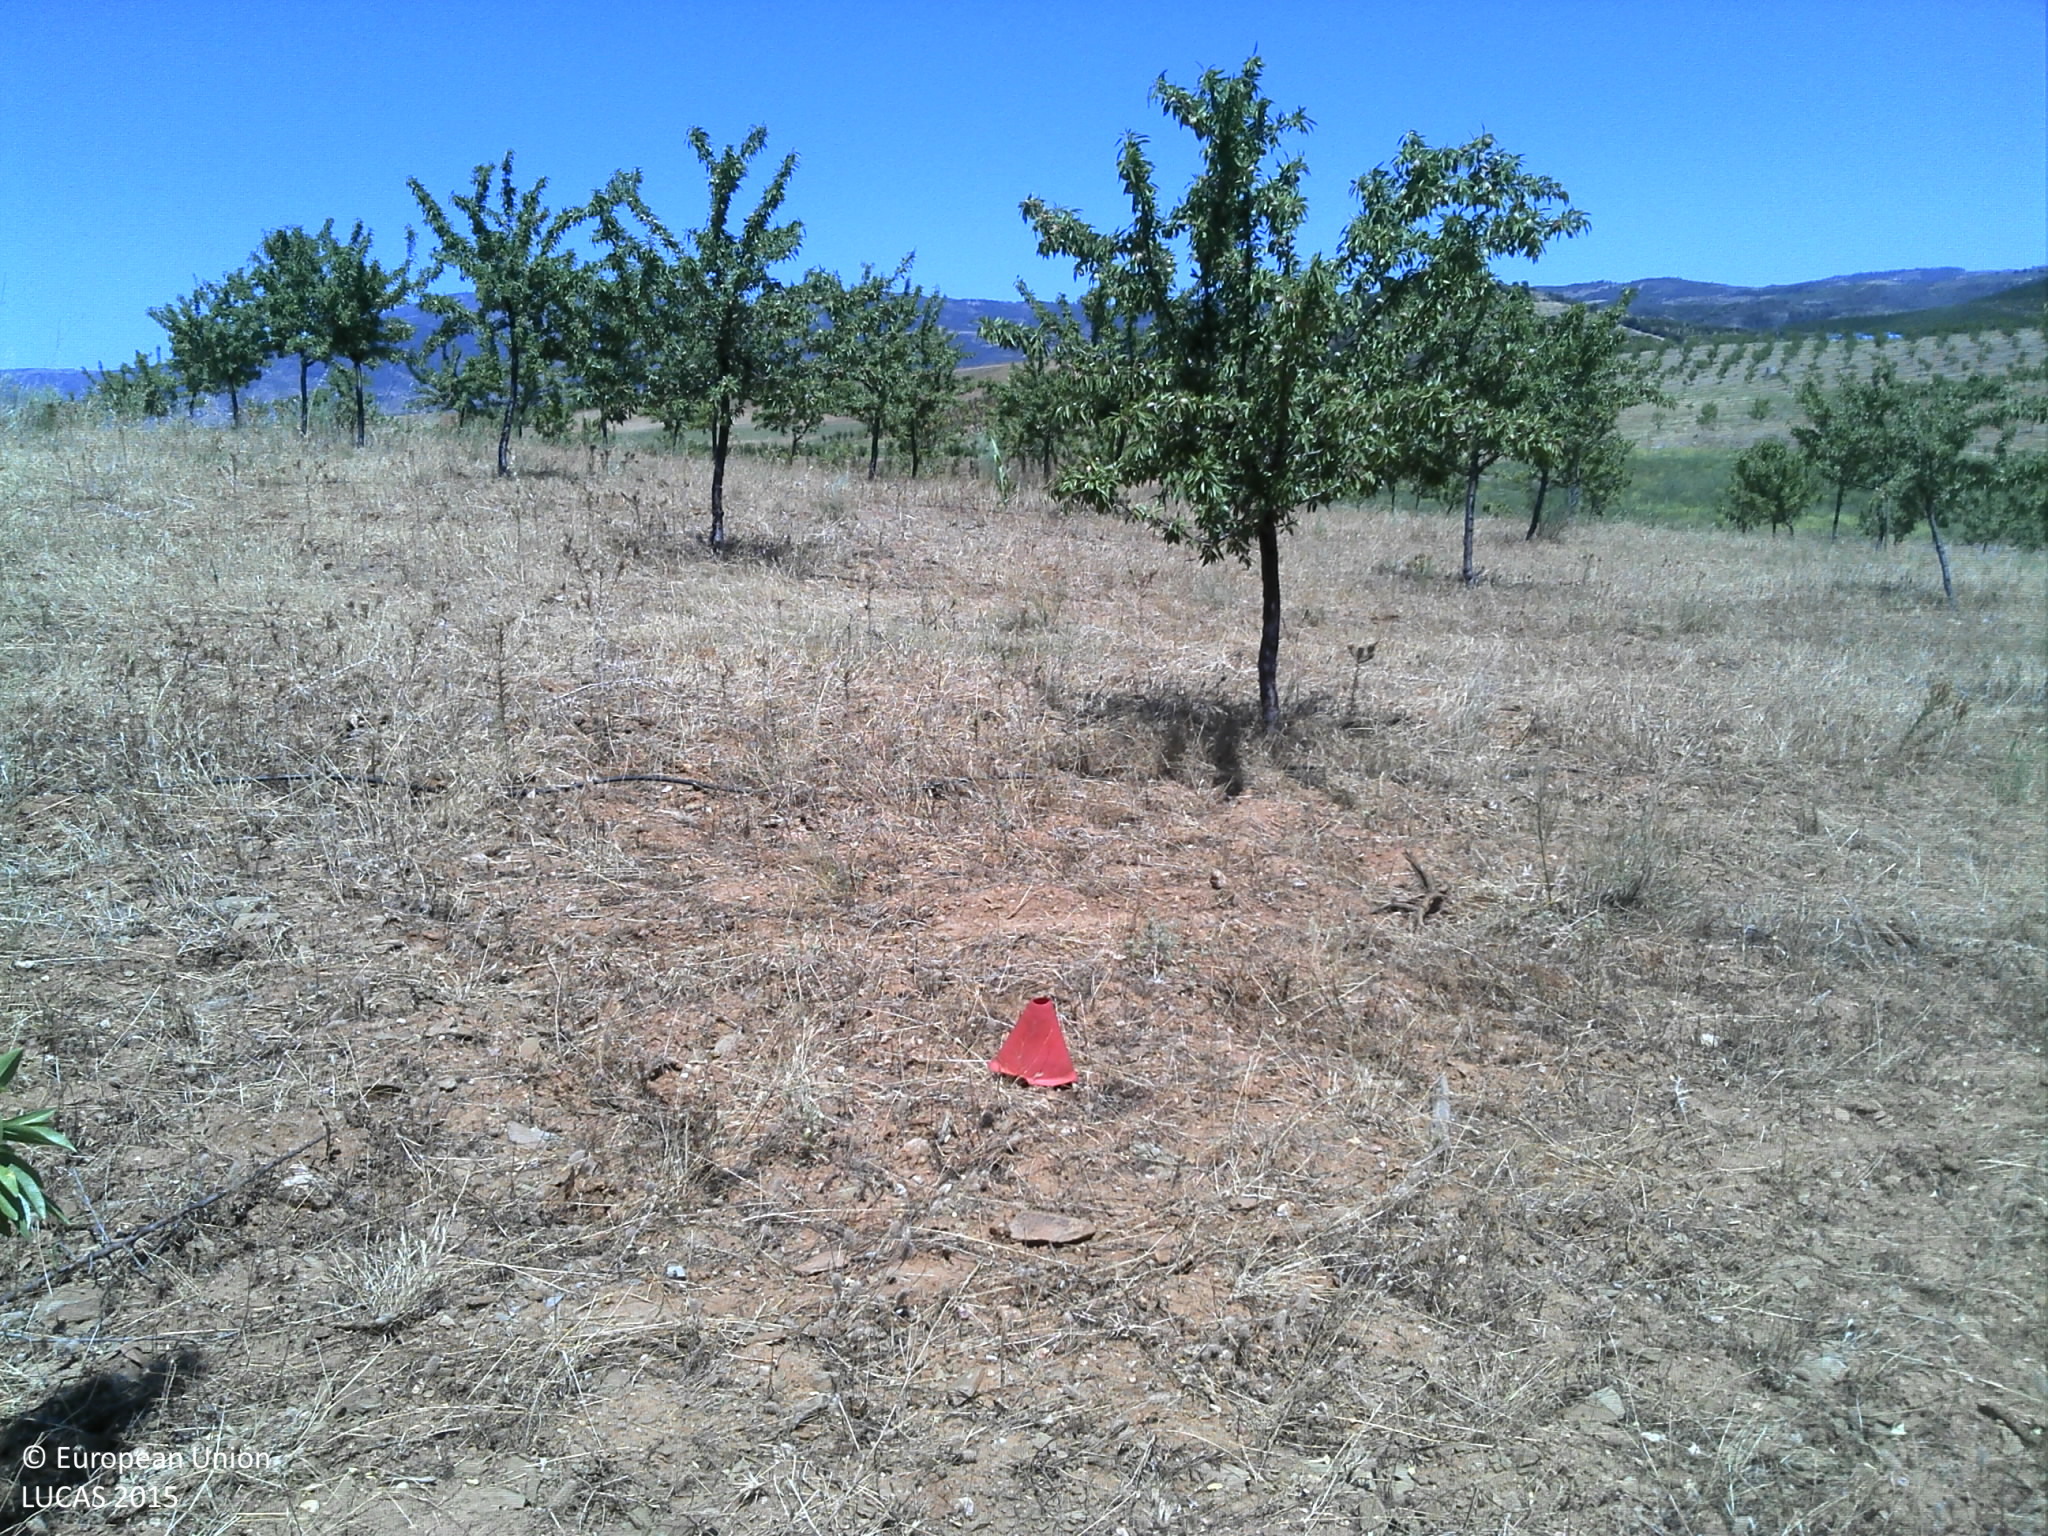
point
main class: Cropland
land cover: Nuts trees
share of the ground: < 10 %
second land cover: Grassland without tree/shrub cover
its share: > 75 %
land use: Agriculture (excluding fallow land and kitchen gardens)
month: July
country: PT
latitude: 41.3220
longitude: -7.0660
